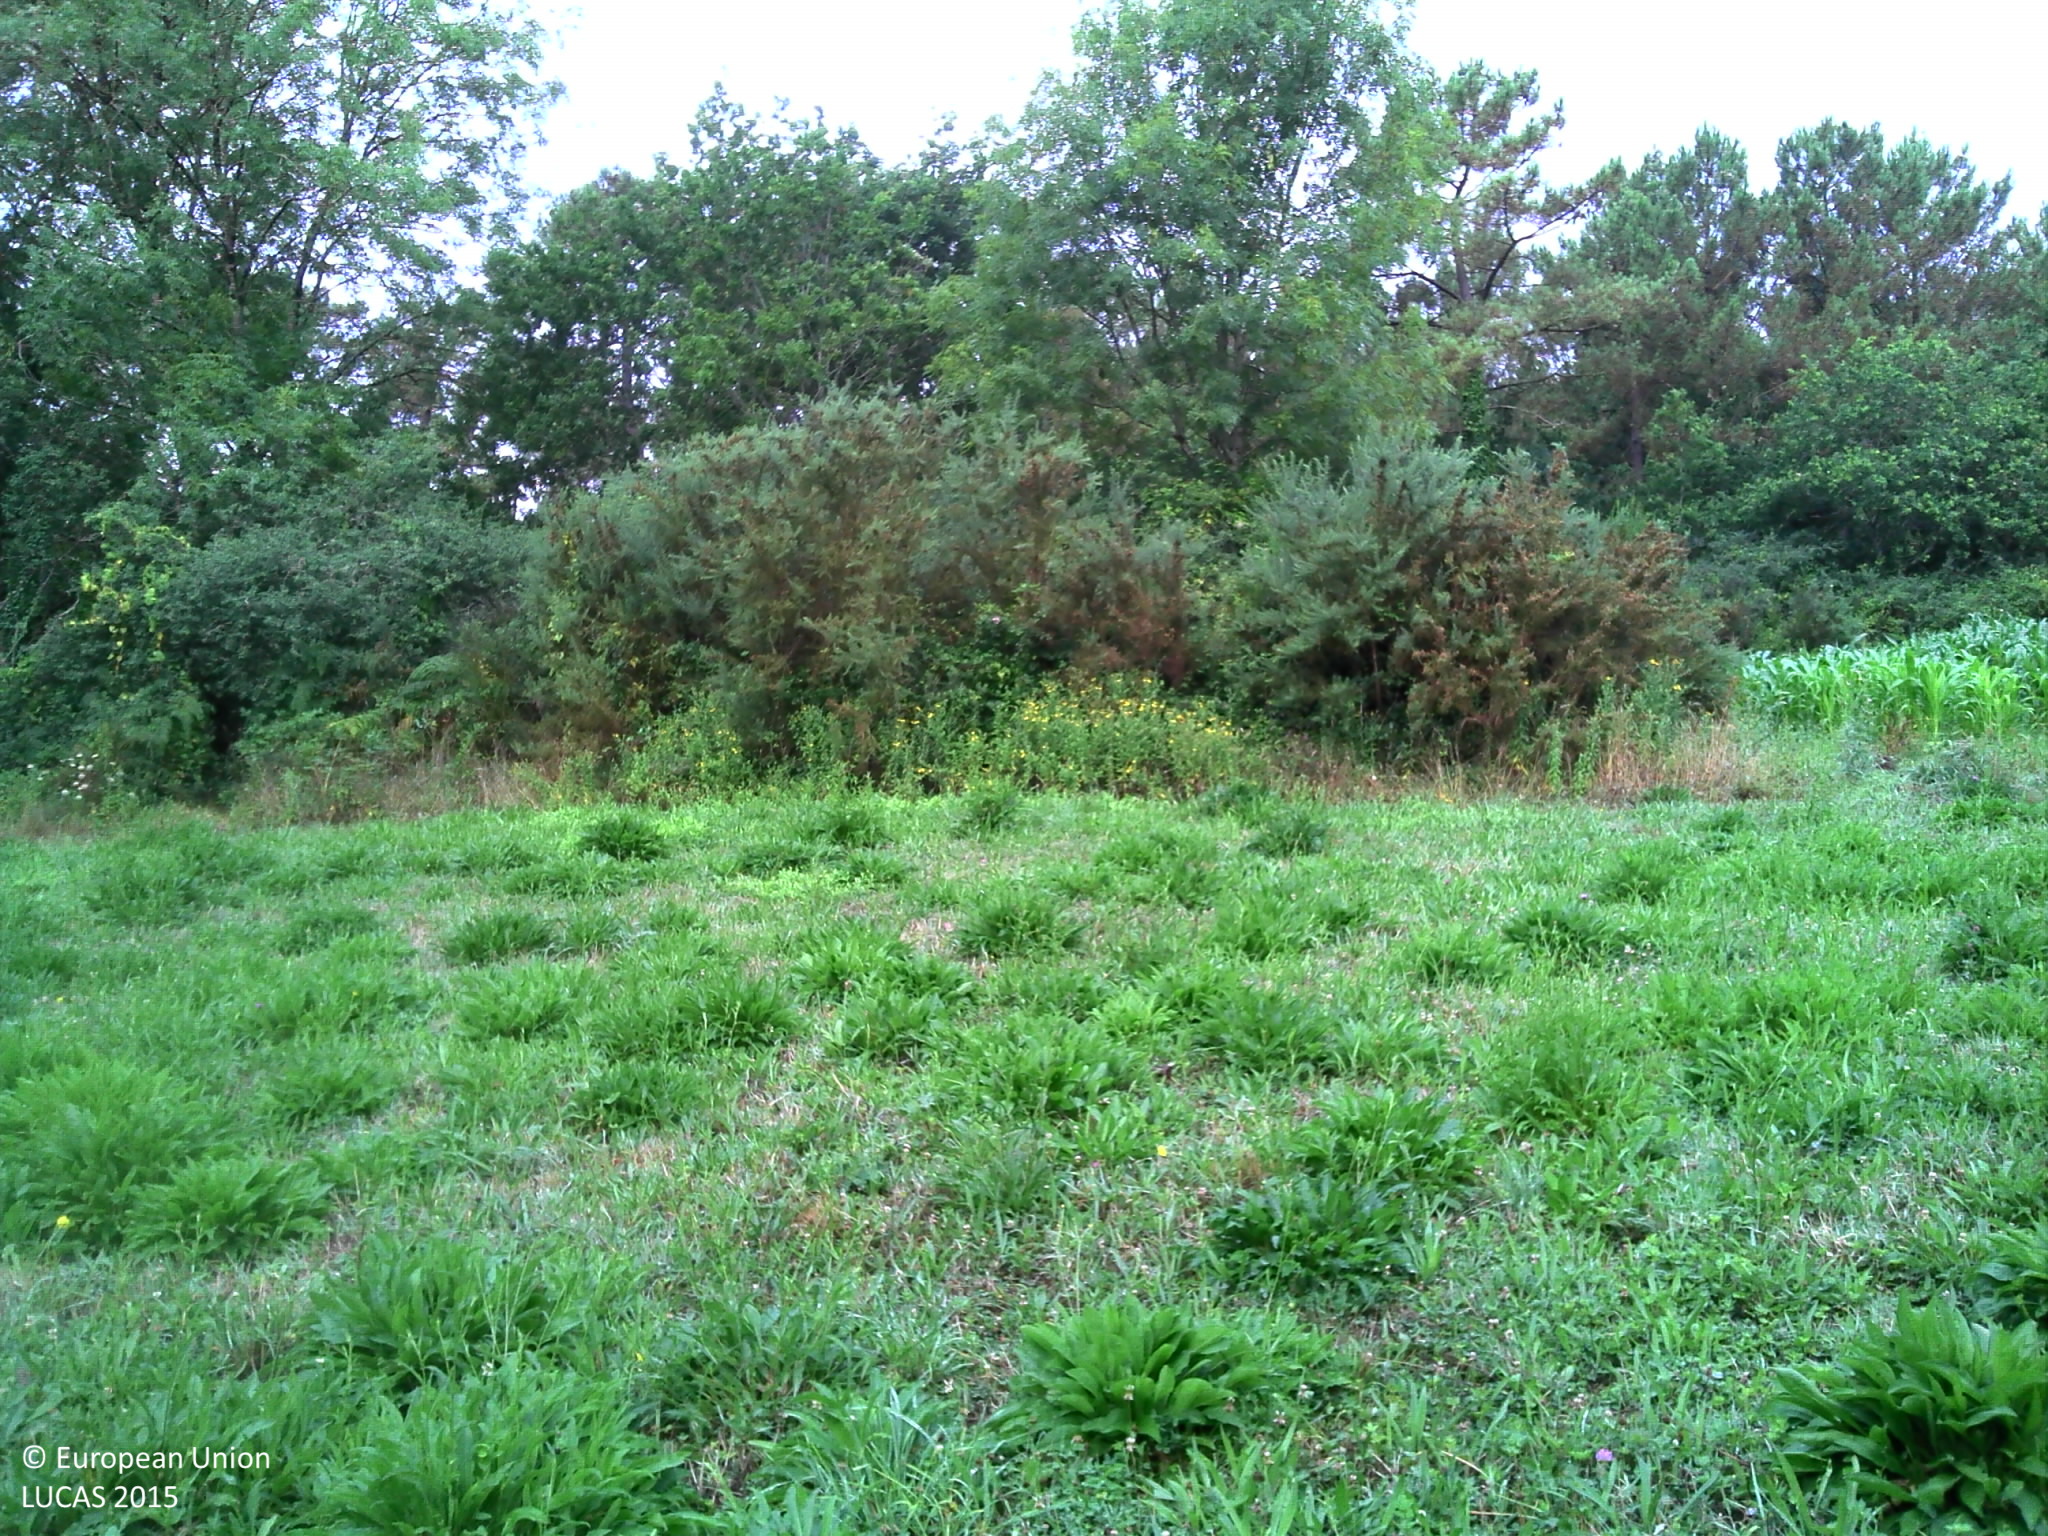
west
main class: Grassland
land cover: Grassland without tree/shrub cover
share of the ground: > 75 %
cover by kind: herbaceous plants 80 %, consolidated bare surface 20 %
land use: Agriculture (excluding fallow land and kitchen gardens)
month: July
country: FR
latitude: 47.6321
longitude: -3.1506
